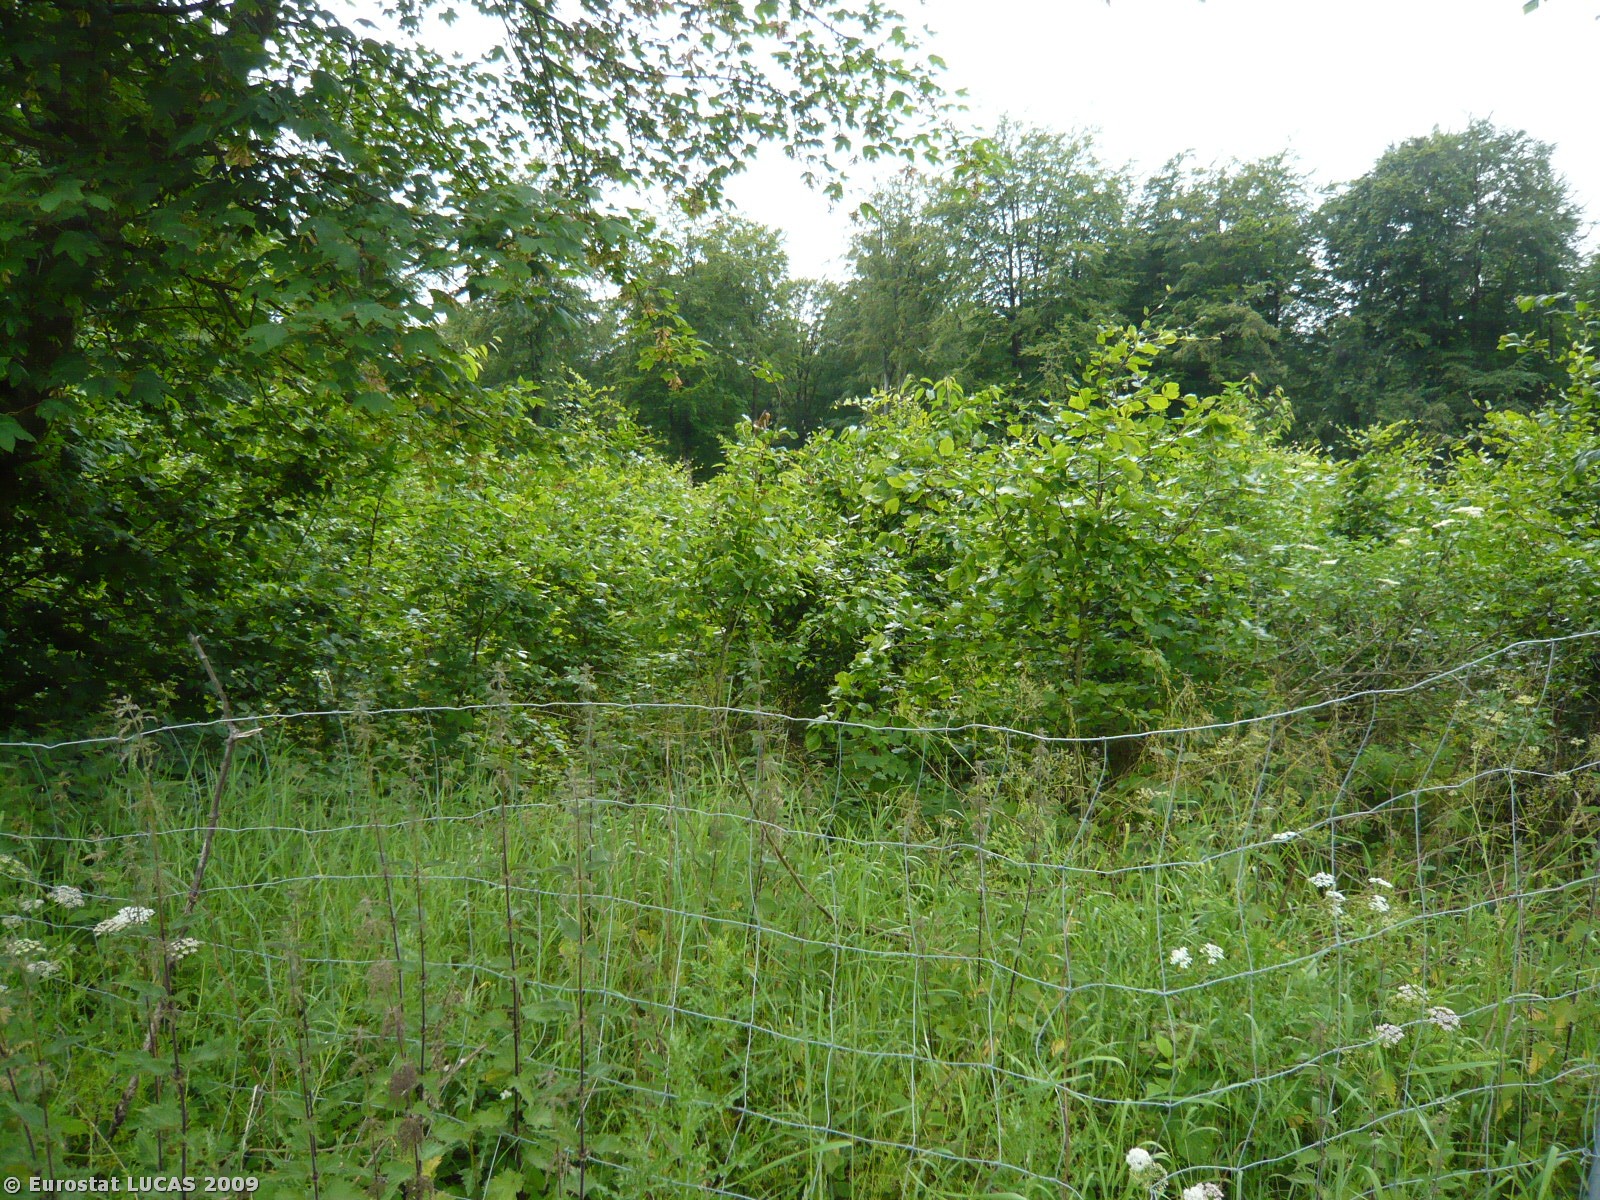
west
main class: Woodland
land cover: Broadleaved woodland
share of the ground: > 75 %
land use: Forestry
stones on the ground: < 10 %
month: June
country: DK
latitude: 55.1616
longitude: 10.6430
